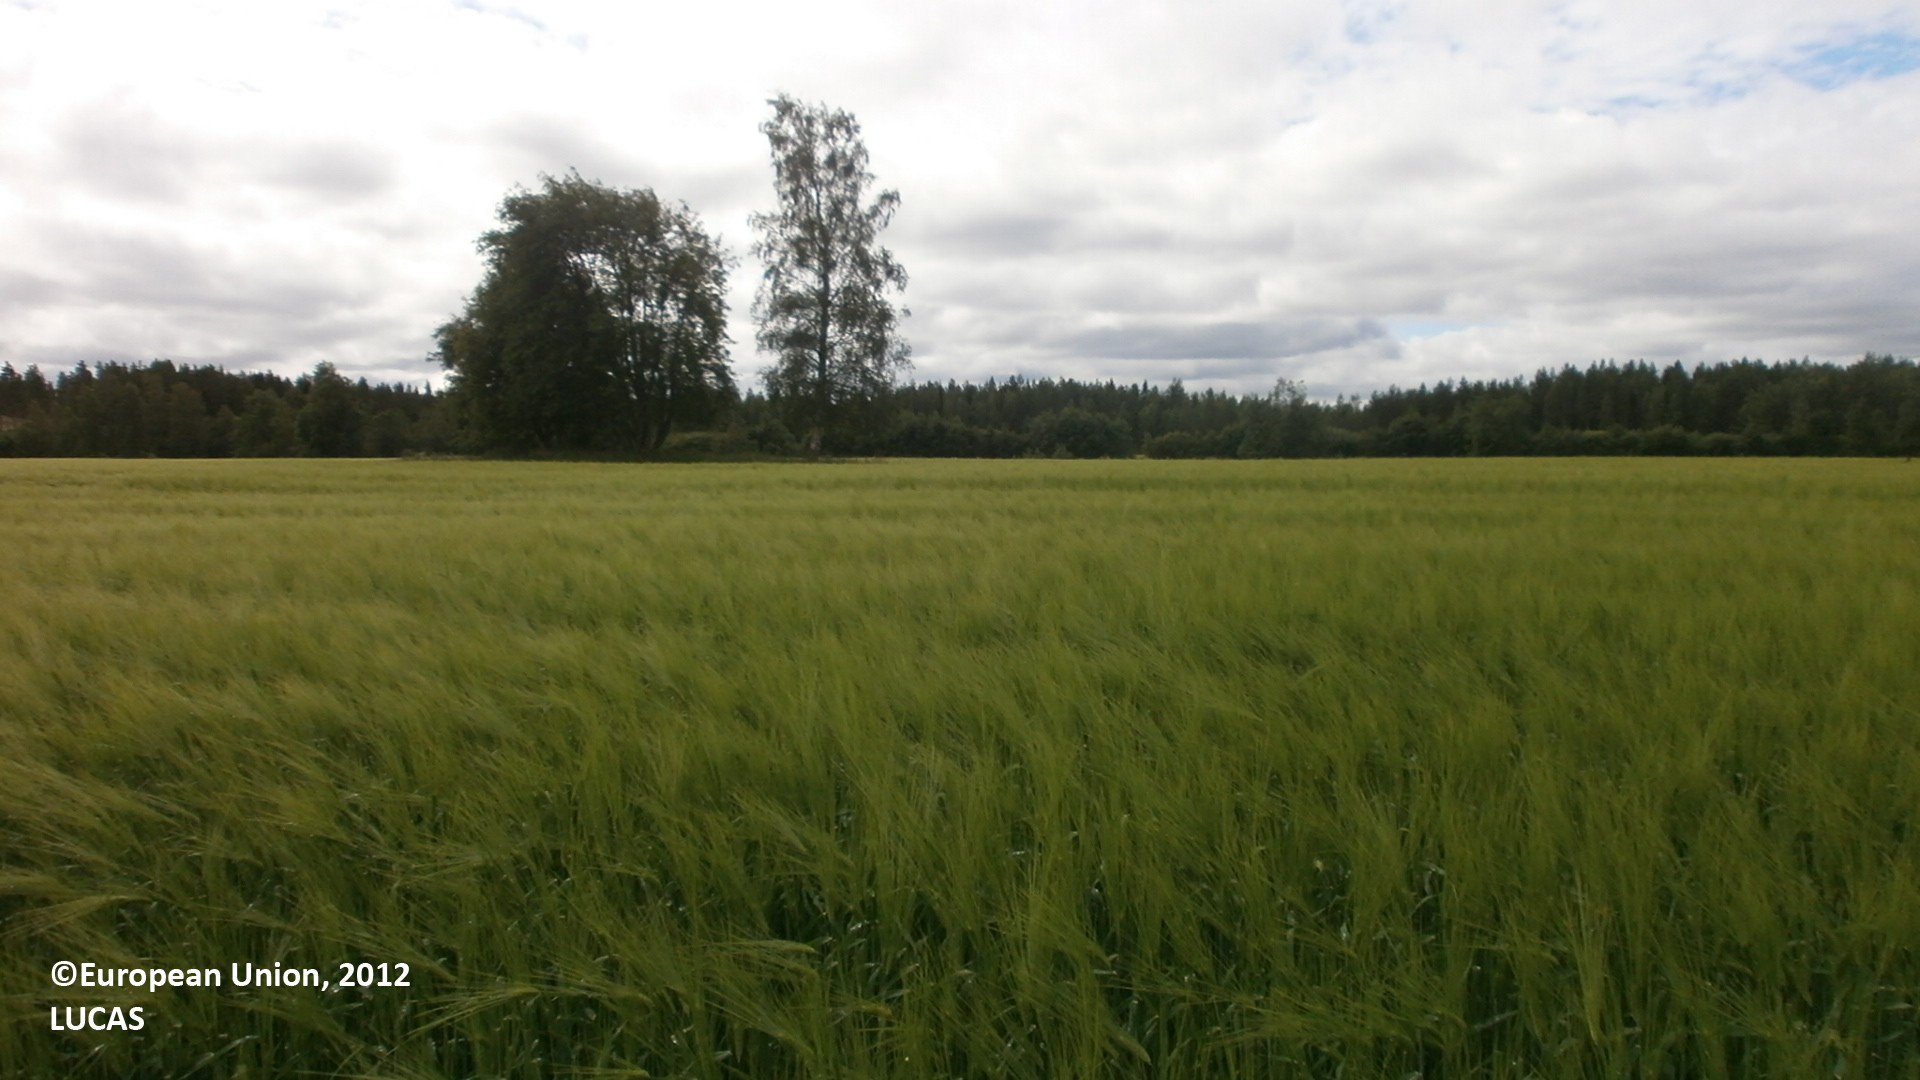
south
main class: Cropland
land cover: Barley
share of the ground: > 75 %
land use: Agriculture (excluding fallow land and kitchen gardens)
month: July
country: FI
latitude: 63.9993
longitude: 23.7388
